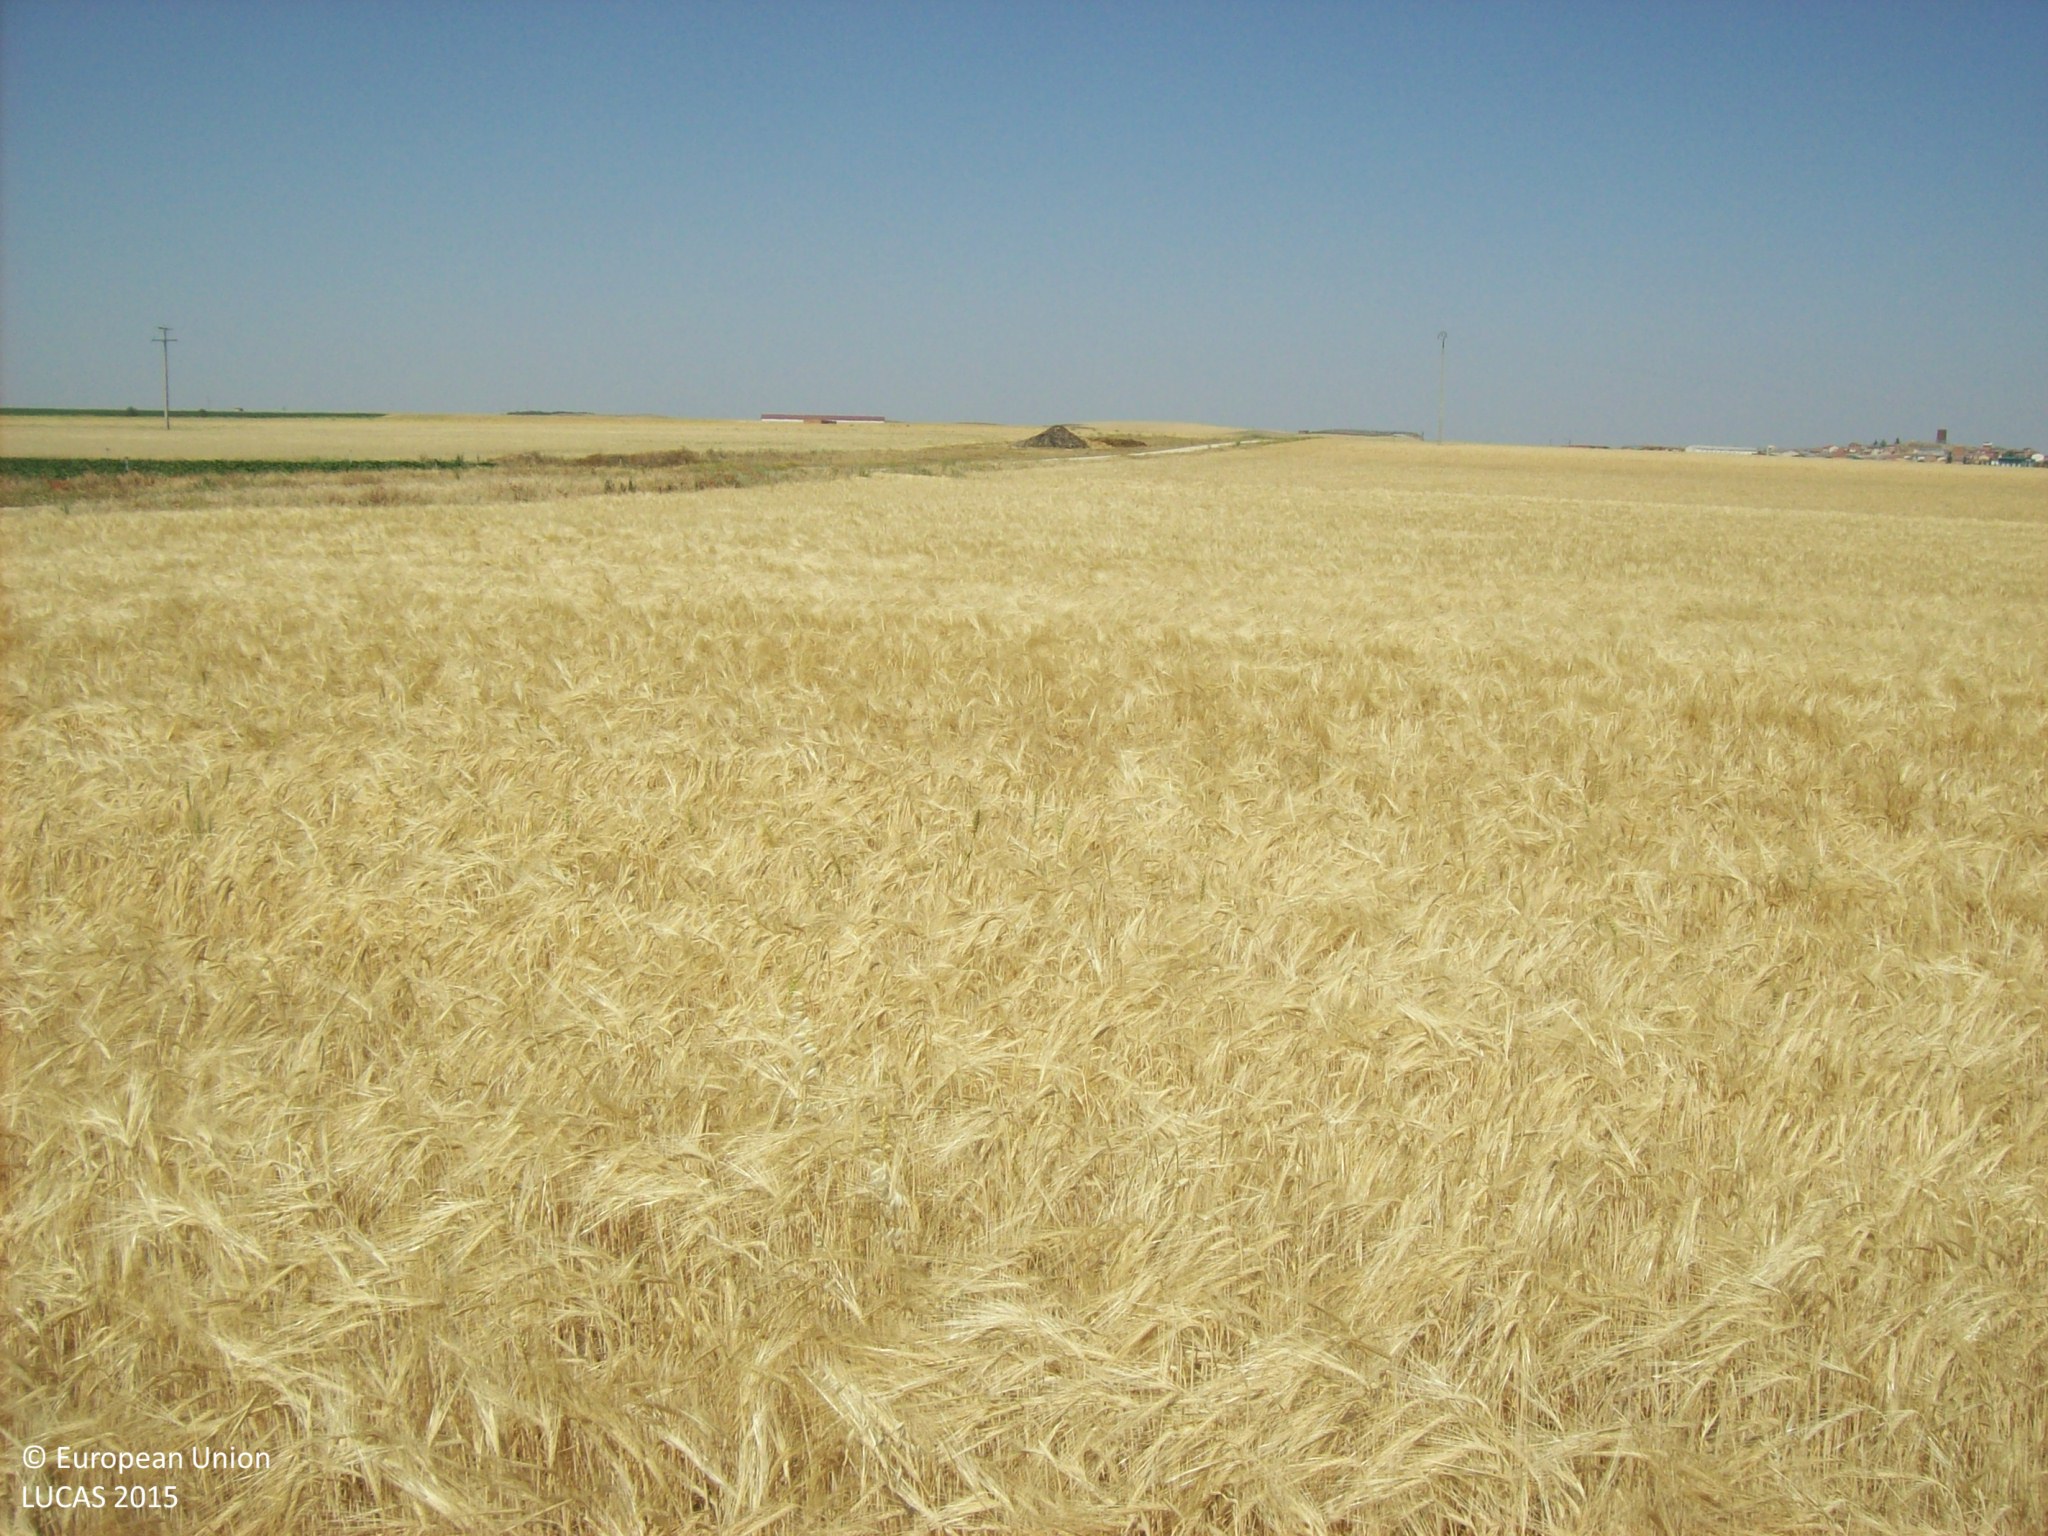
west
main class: Cropland
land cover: Barley
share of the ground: > 75 %
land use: Agriculture (excluding fallow land and kitchen gardens)
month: June
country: ES
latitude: 41.2050
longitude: -5.0839
